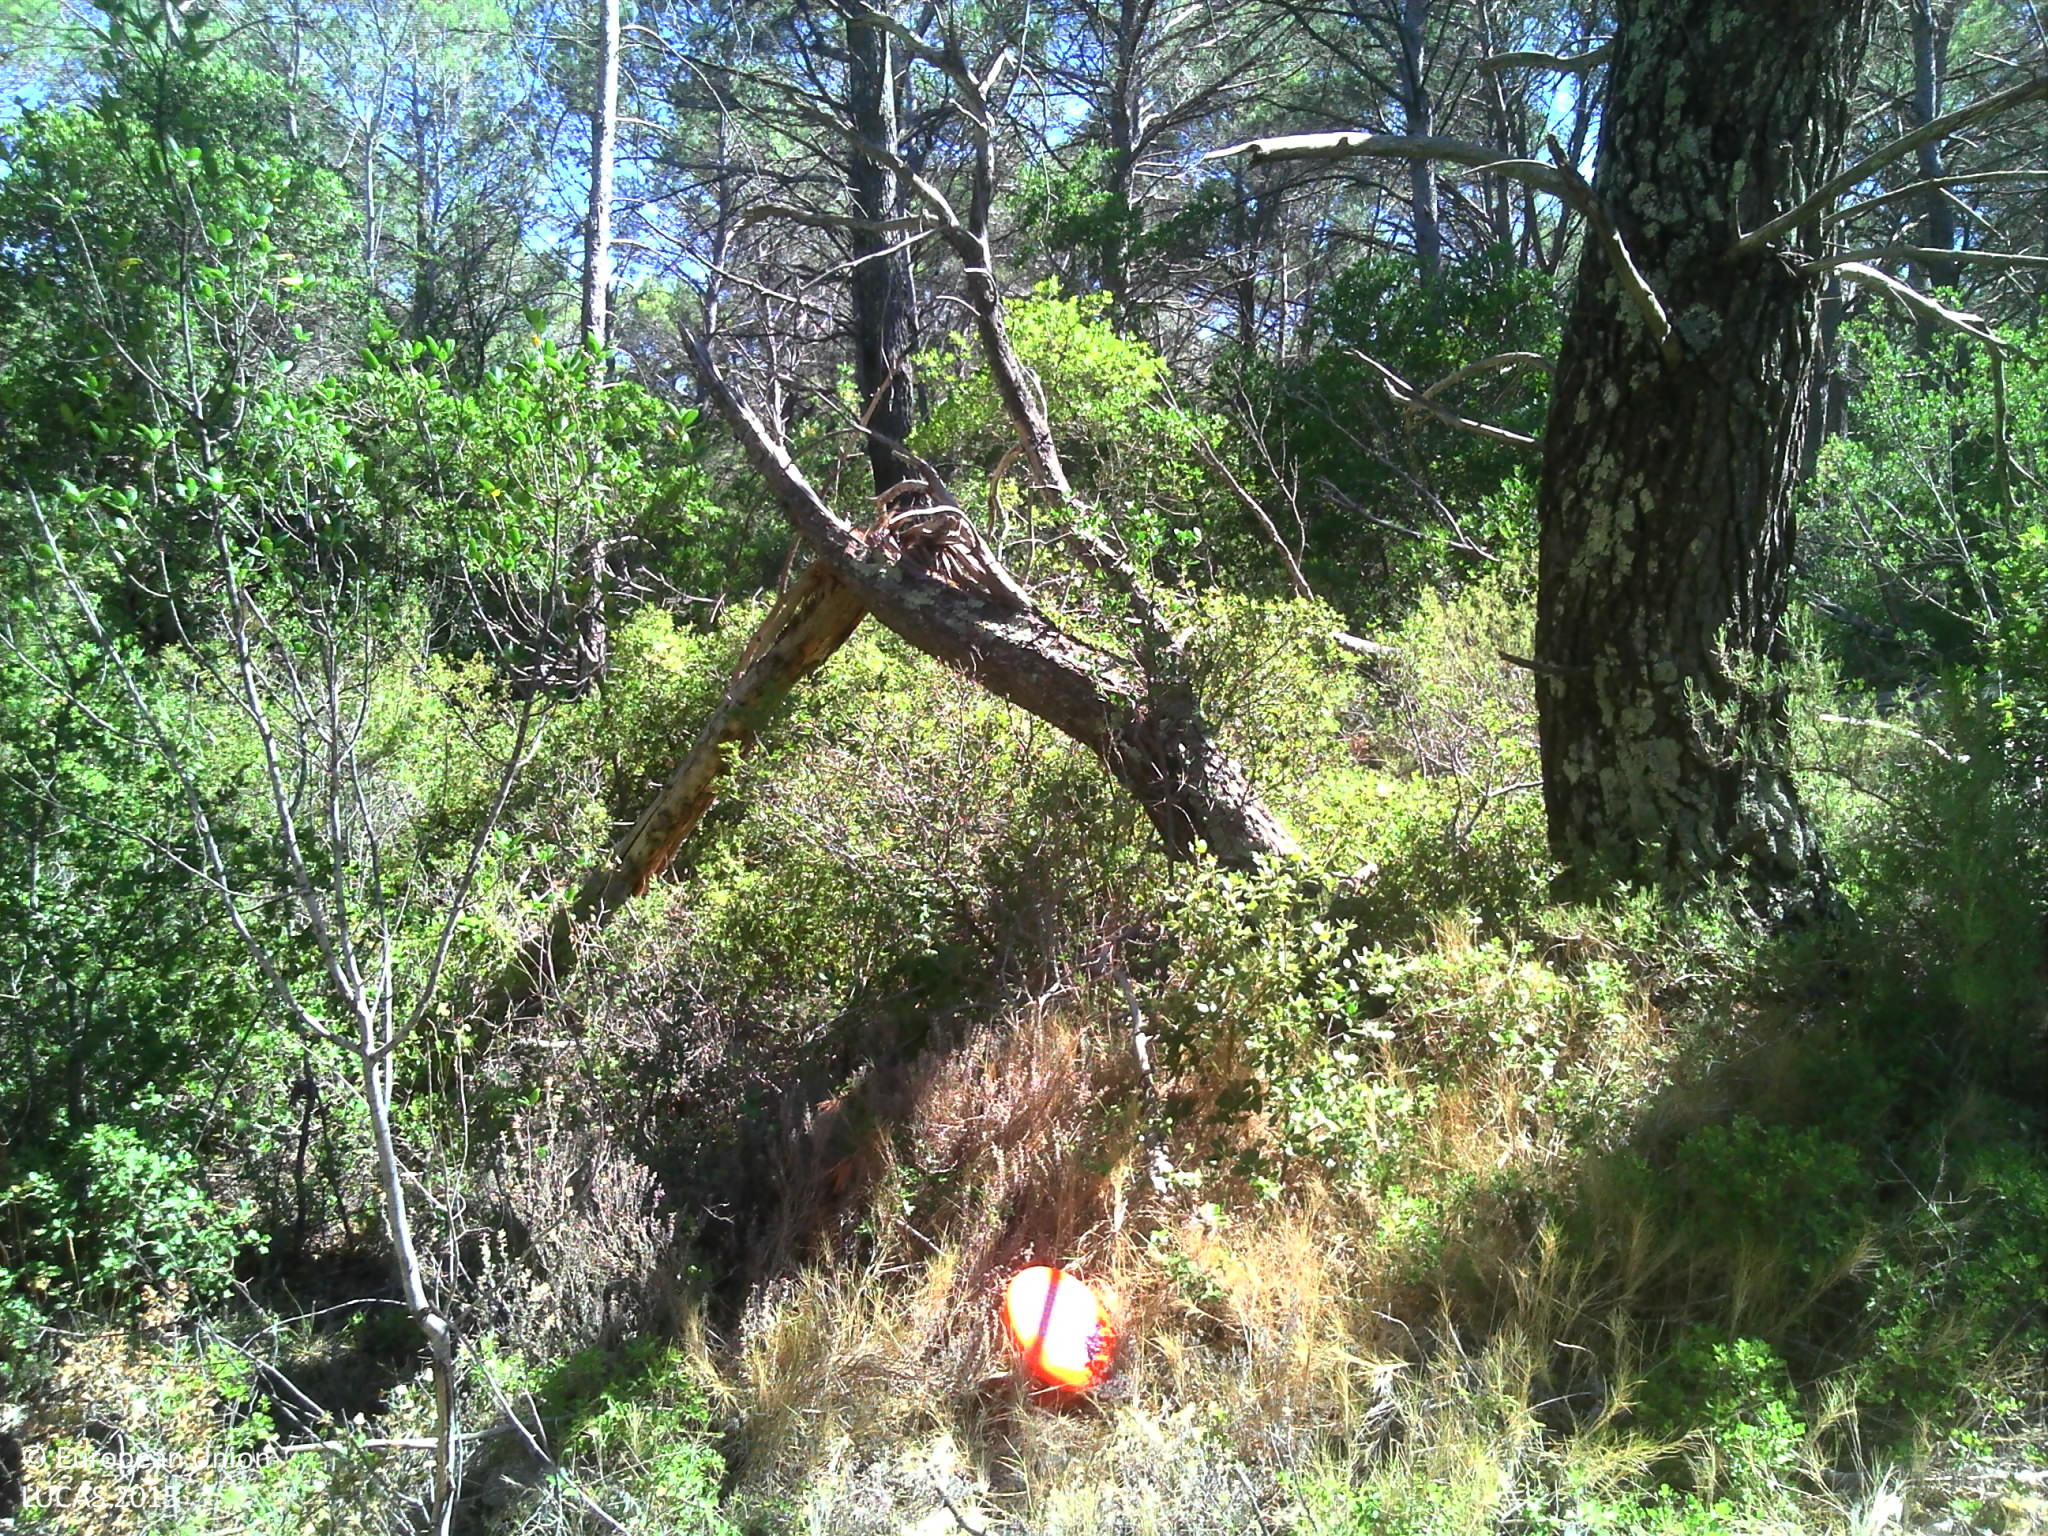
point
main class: Woodland
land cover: Pine dominated coniferous woodland
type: coniferous forest of the mediterranean region
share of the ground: 25 - 50 %
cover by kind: coniferous forest trees 50 %, shrubs 40 %, herbaceous plants 10 %
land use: Semi-natural and natural areas not in use
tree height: > 5 m
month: July
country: FR
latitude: 43.2512
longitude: 5.7362
